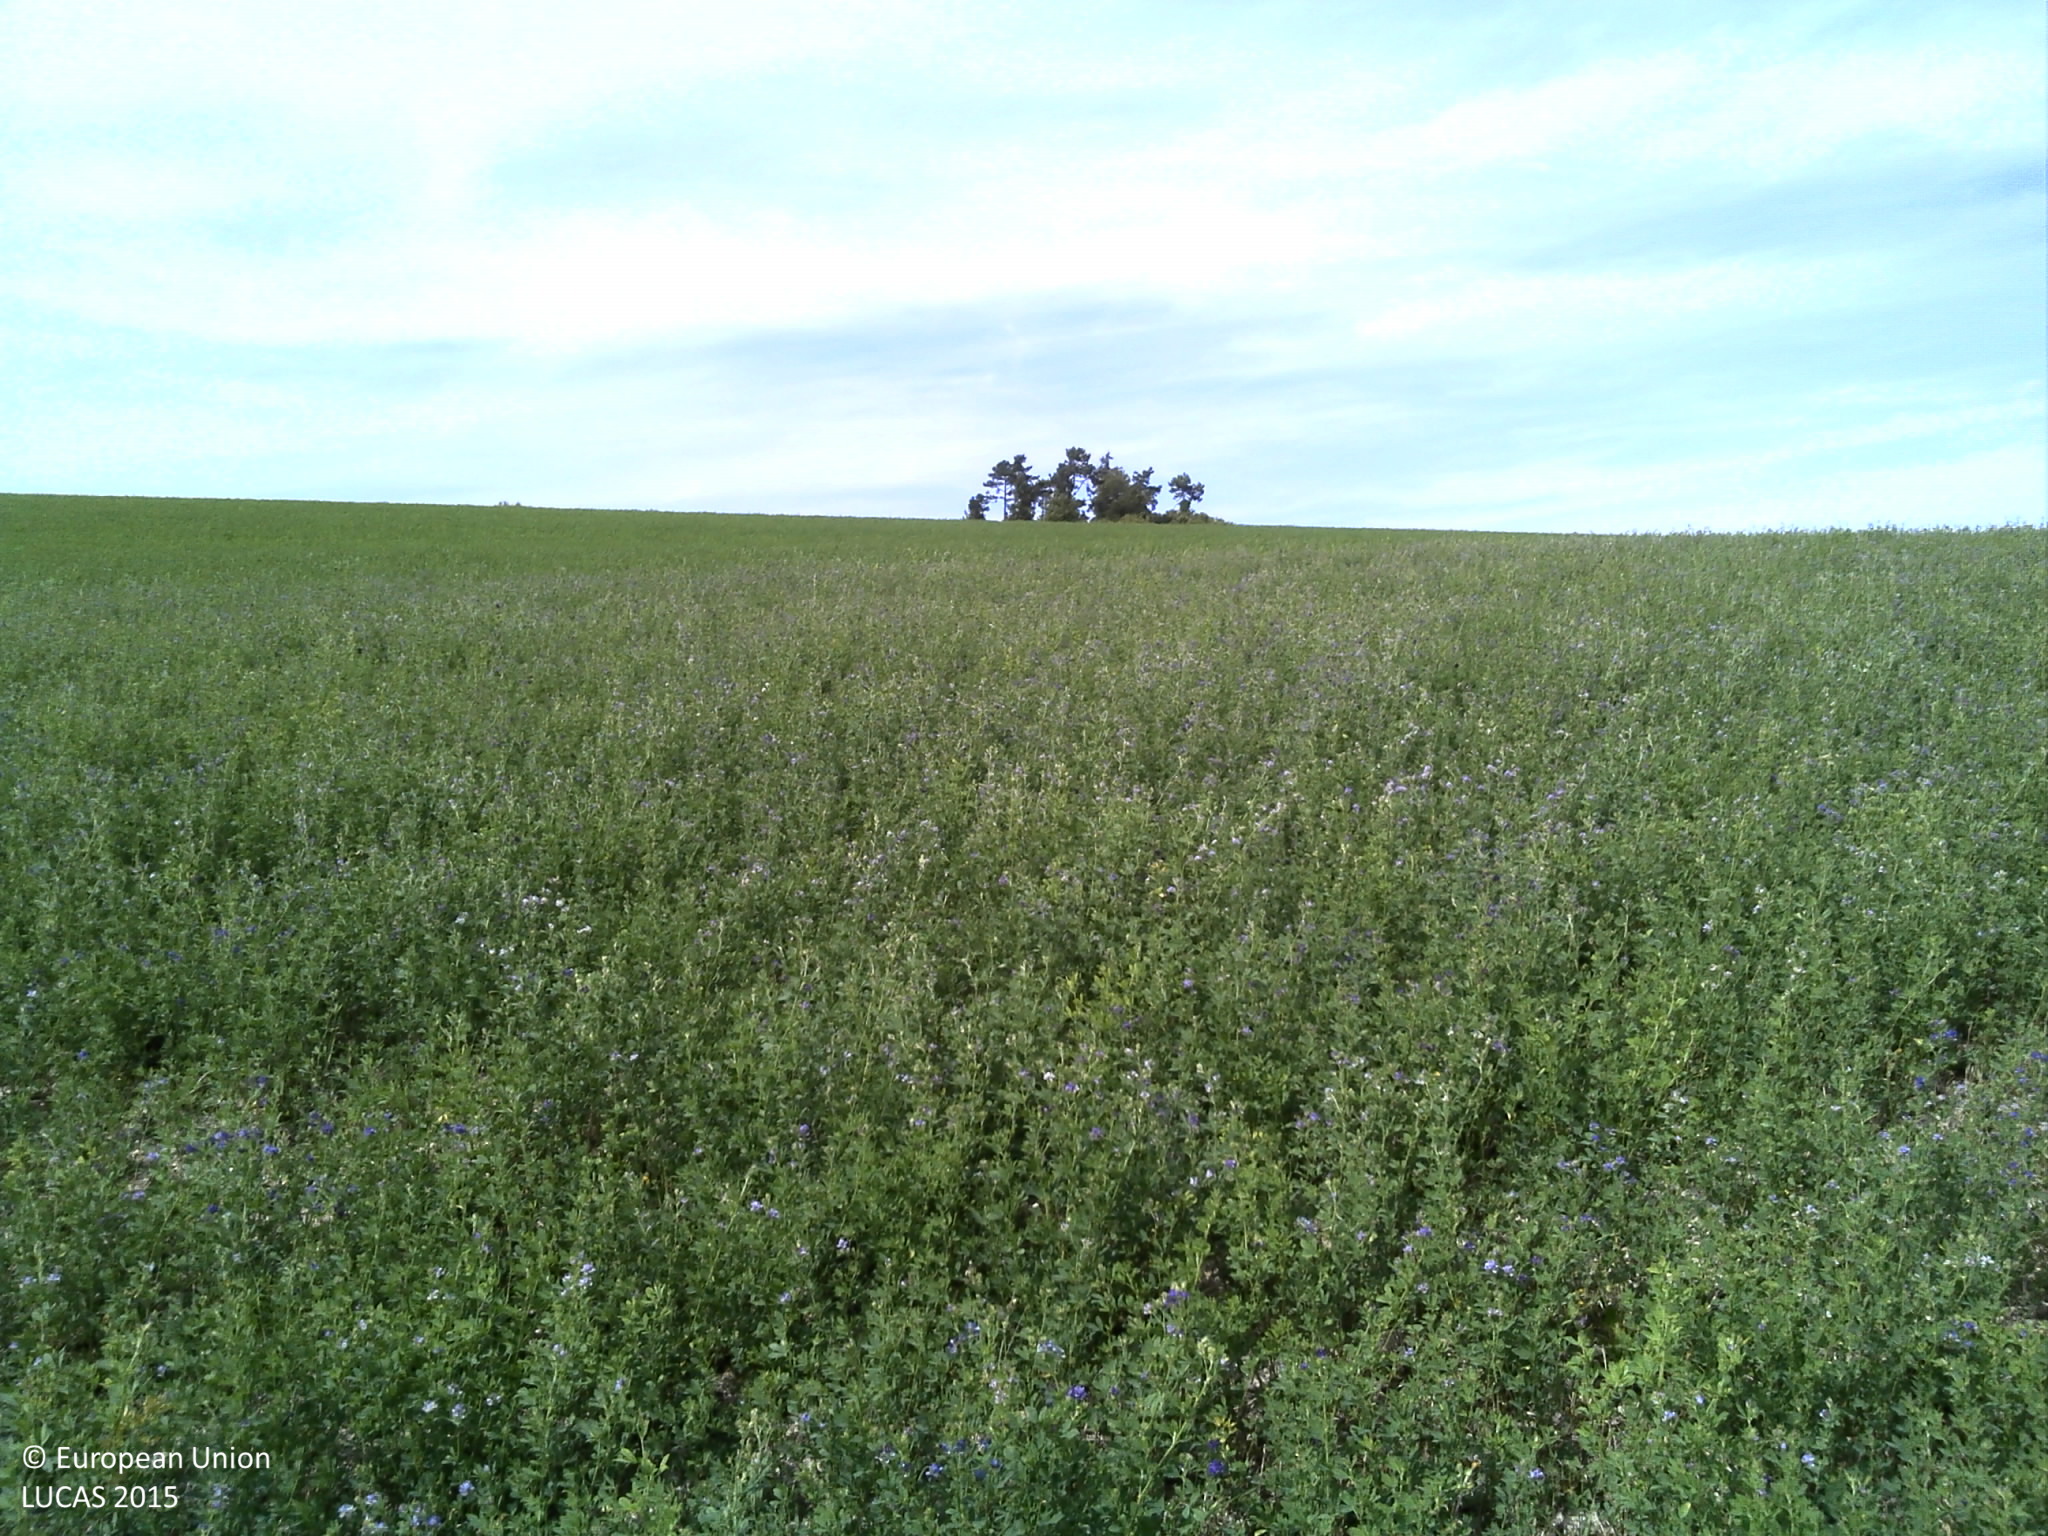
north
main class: Cropland
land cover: Lucerne
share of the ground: > 75 %
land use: Agriculture (excluding fallow land and kitchen gardens)
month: August
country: FR
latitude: 49.0197
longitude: 4.7875
